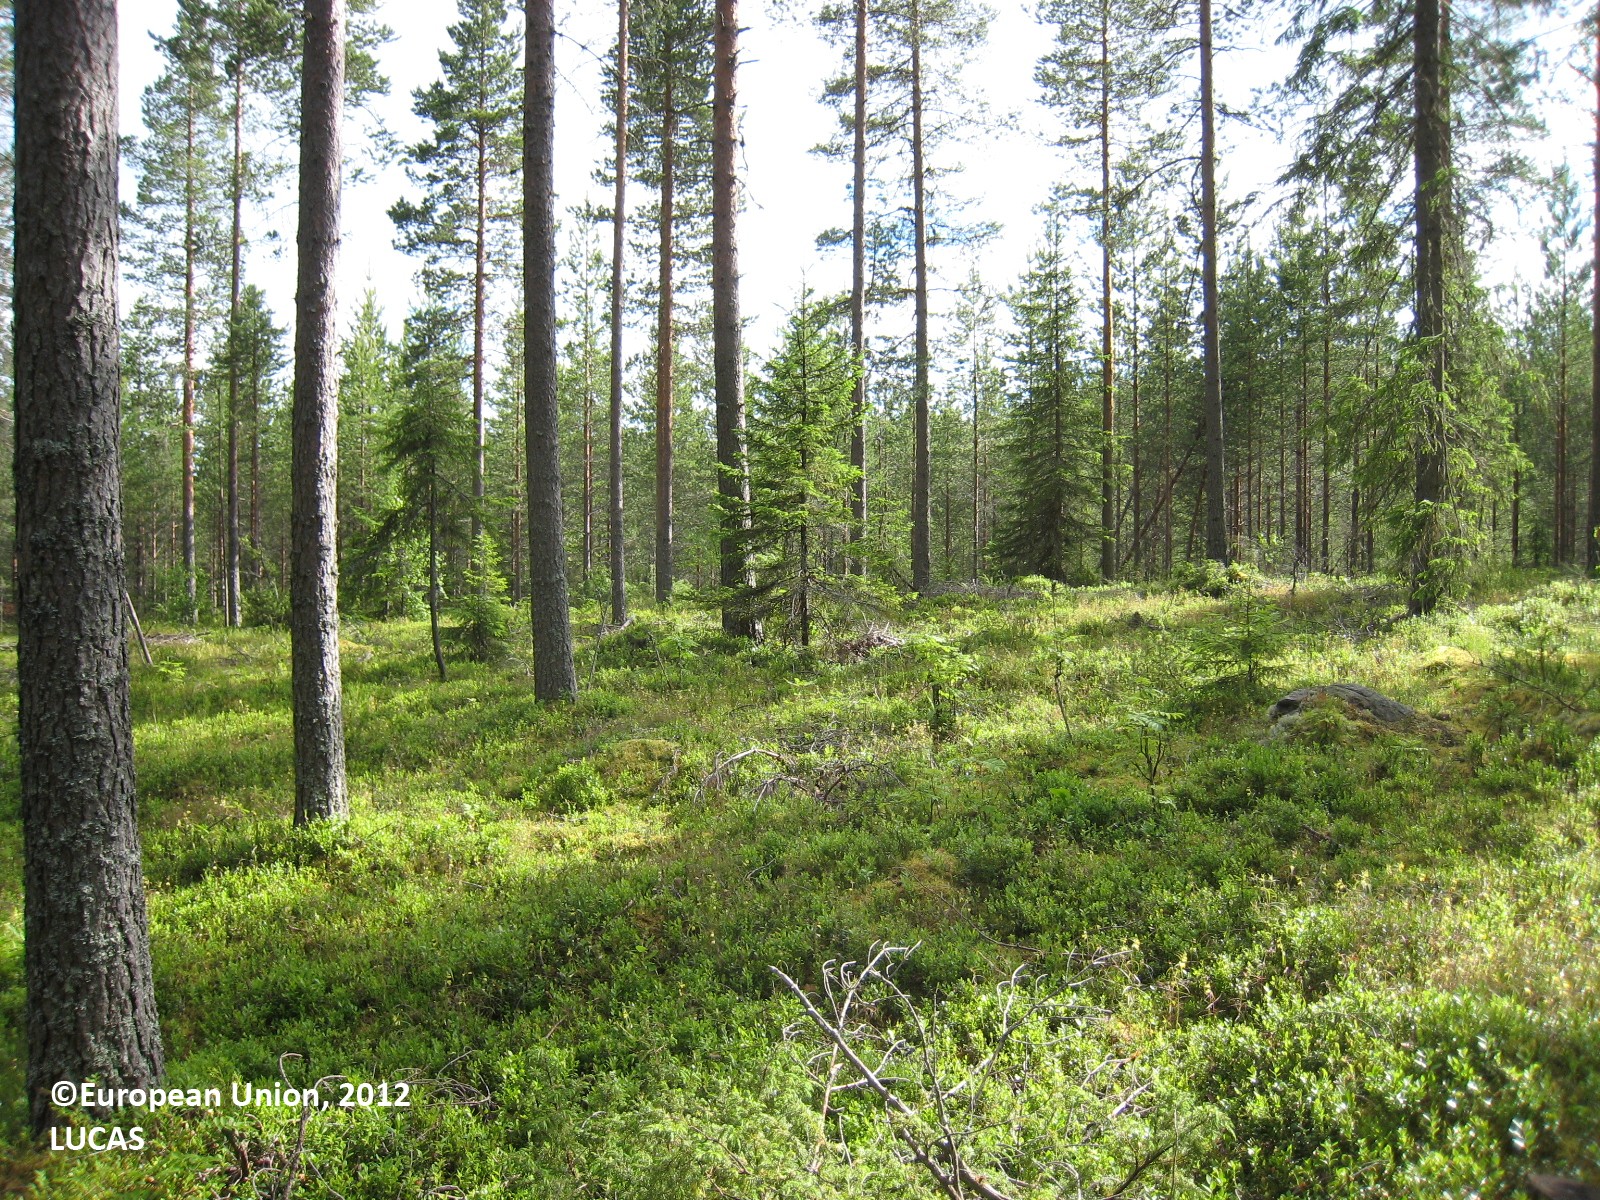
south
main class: Woodland
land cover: Other coniferous woodland
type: boreal forest
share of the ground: 50 - 75 %
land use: Forestry
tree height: > 5 m
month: July
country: FI
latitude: 62.9091
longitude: 25.6808
